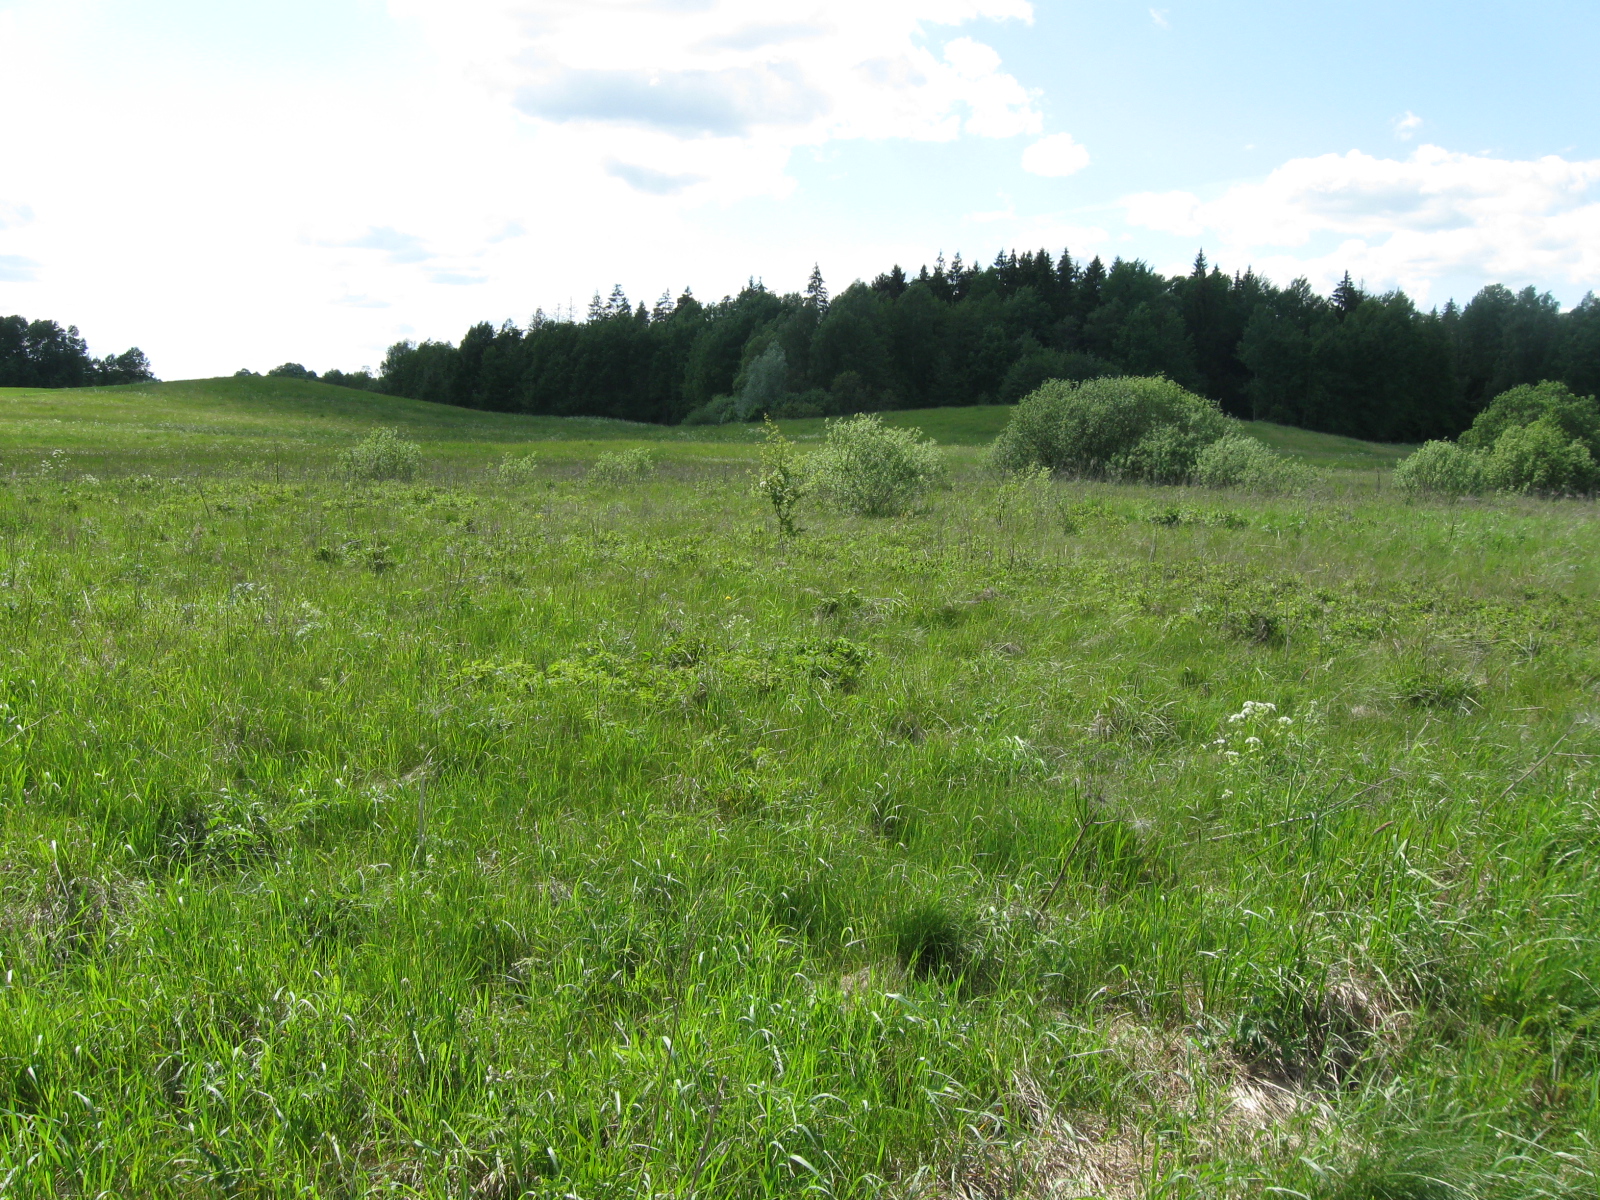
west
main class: Grassland
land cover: Grassland without tree/shrub cover
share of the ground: > 75 %
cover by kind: herbaceous plants 95 %, consolidated bare surface 5 %
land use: Agriculture (excluding fallow land and kitchen gardens)
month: May
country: LT
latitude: 54.2624
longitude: 23.3595
